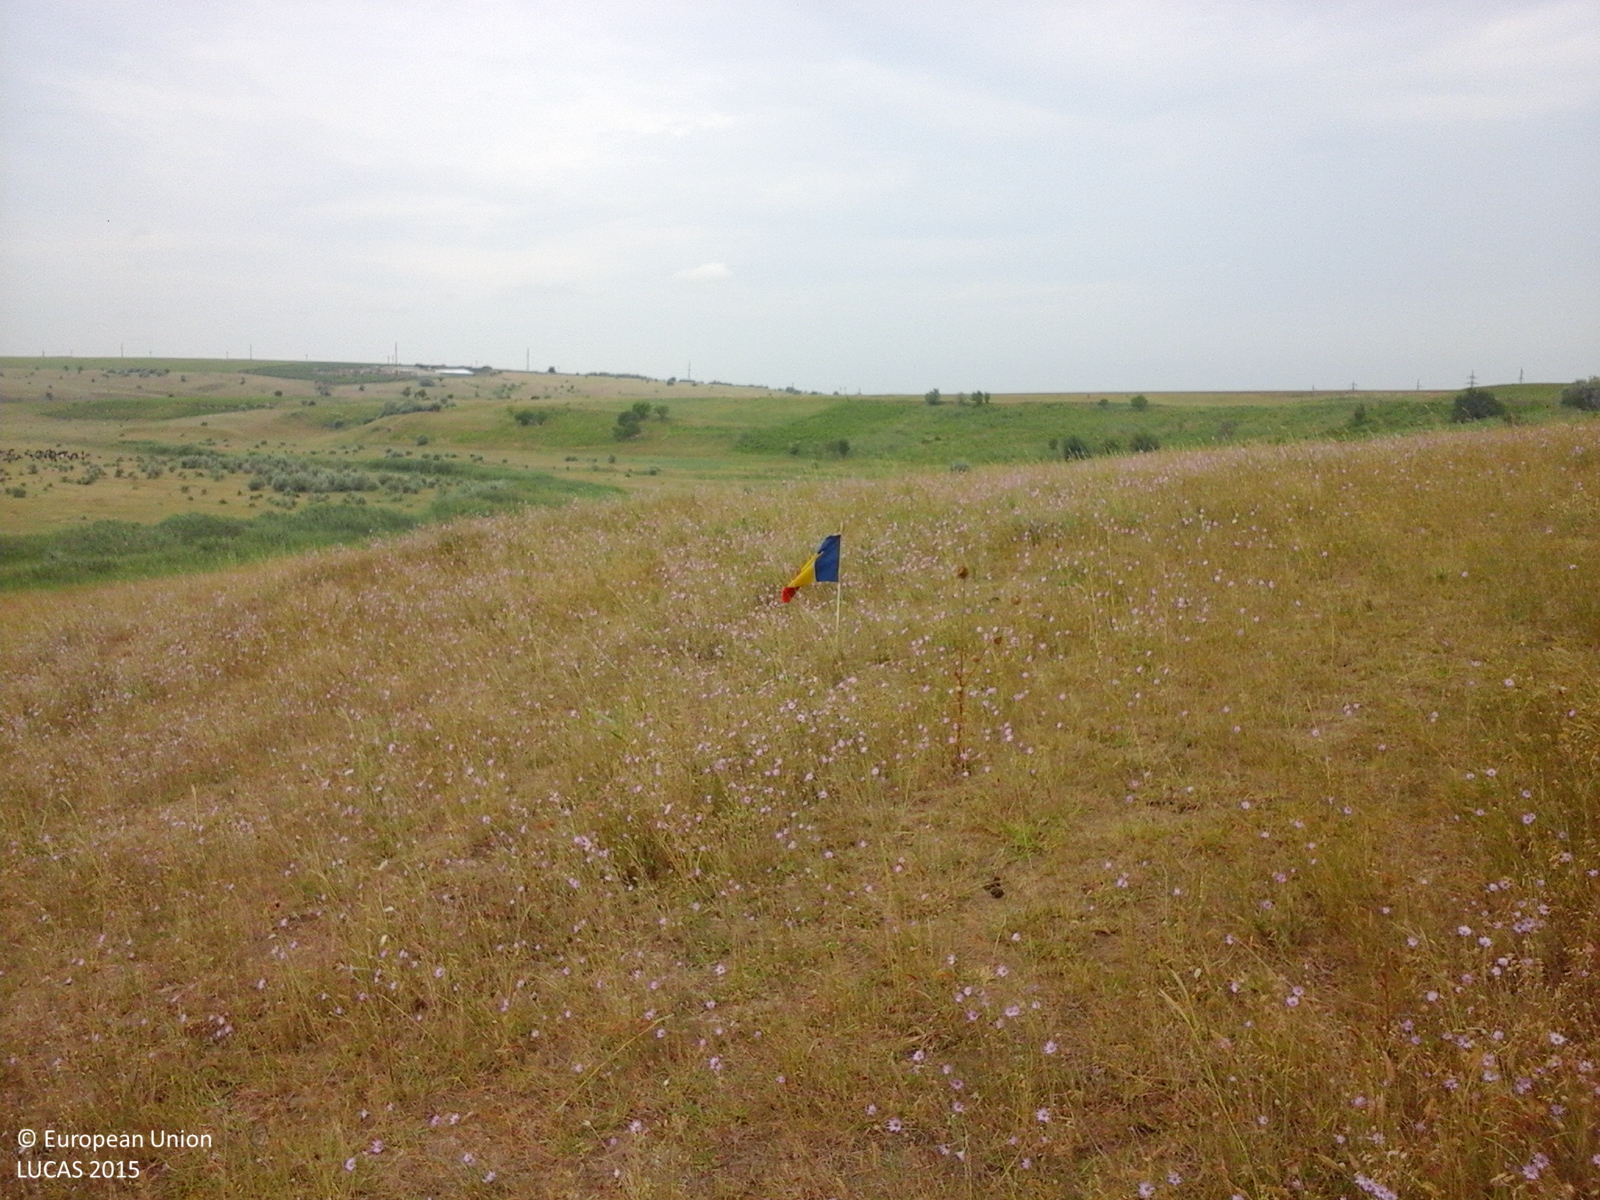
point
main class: Grassland
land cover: Grassland without tree/shrub cover
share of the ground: > 75 %
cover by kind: herbaceous plants 100 %
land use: Agriculture (excluding fallow land and kitchen gardens)
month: August
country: RO
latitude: 44.9078
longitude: 28.1655
